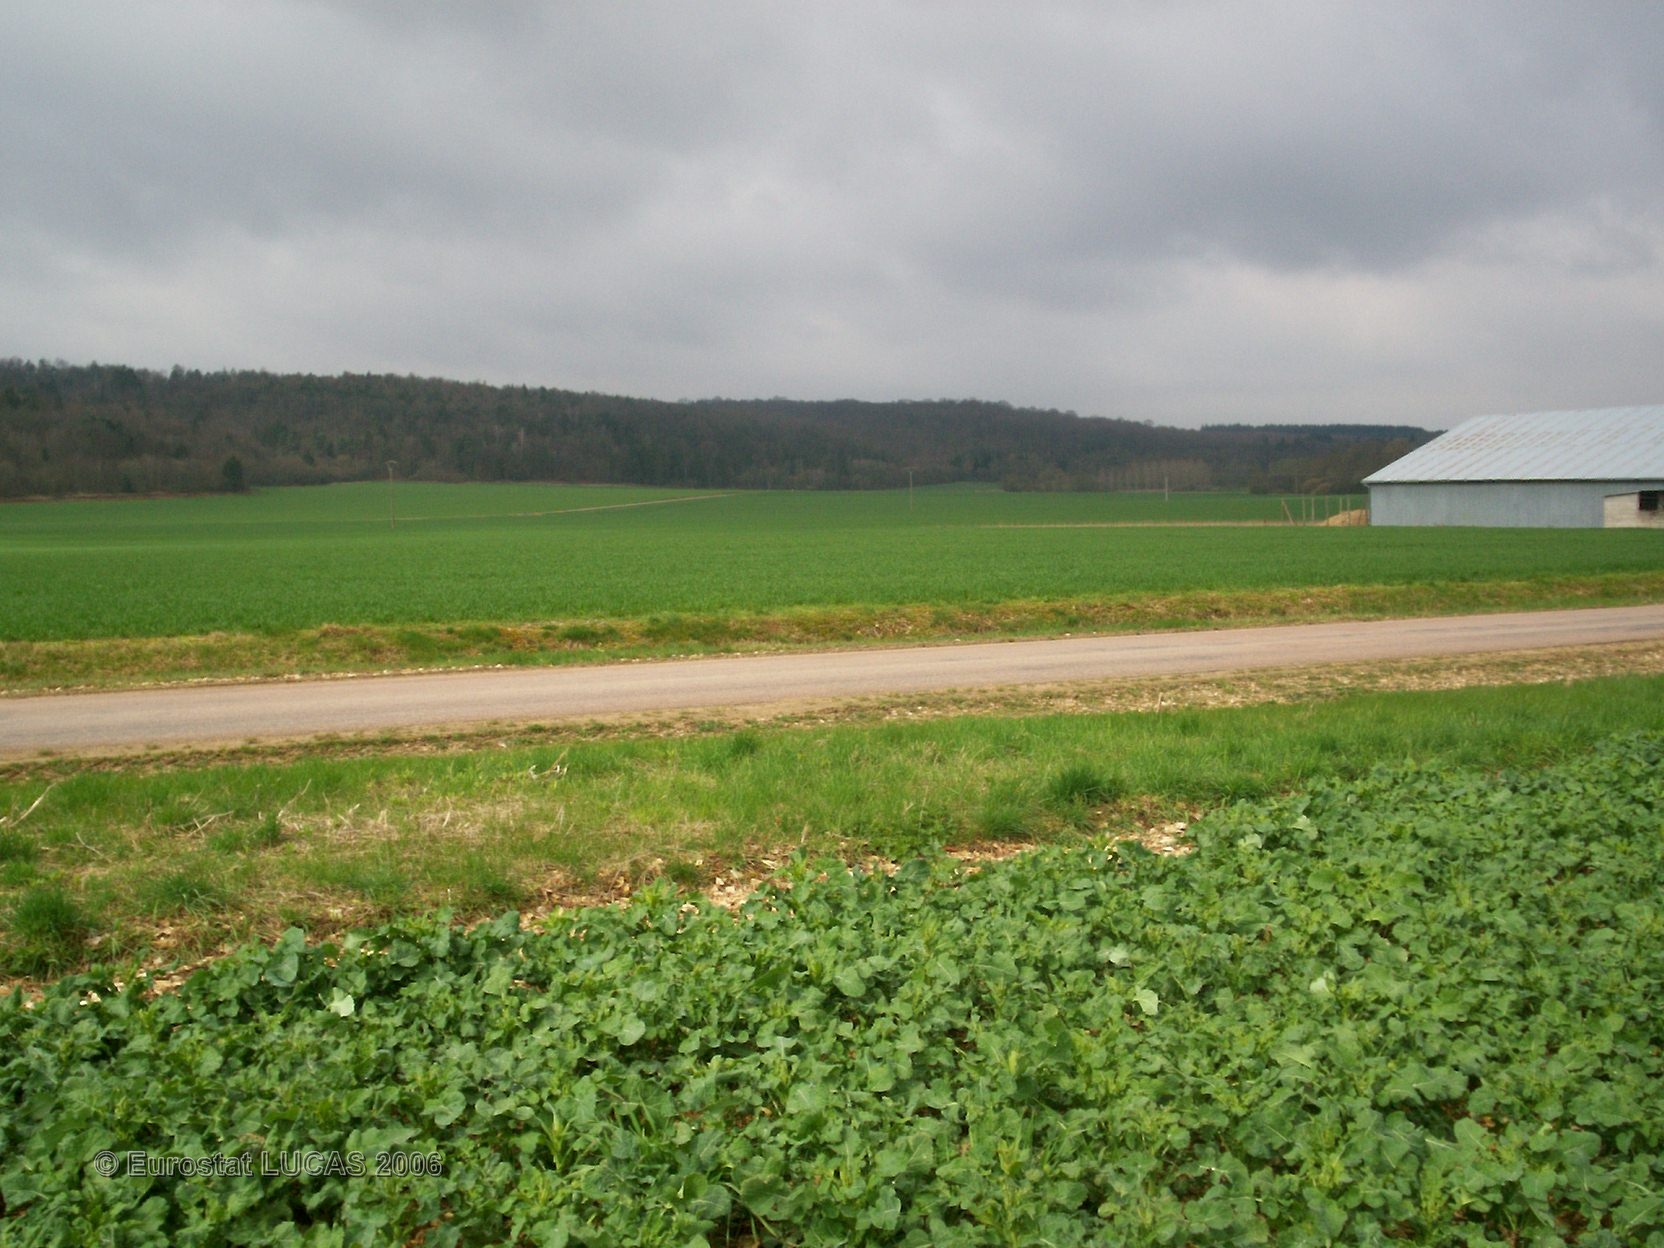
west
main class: Cropland
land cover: Rape and turnip rape
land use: Agriculture (excluding fallow land and kitchen gardens)
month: April
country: FR
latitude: 48.0355
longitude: 4.5664
